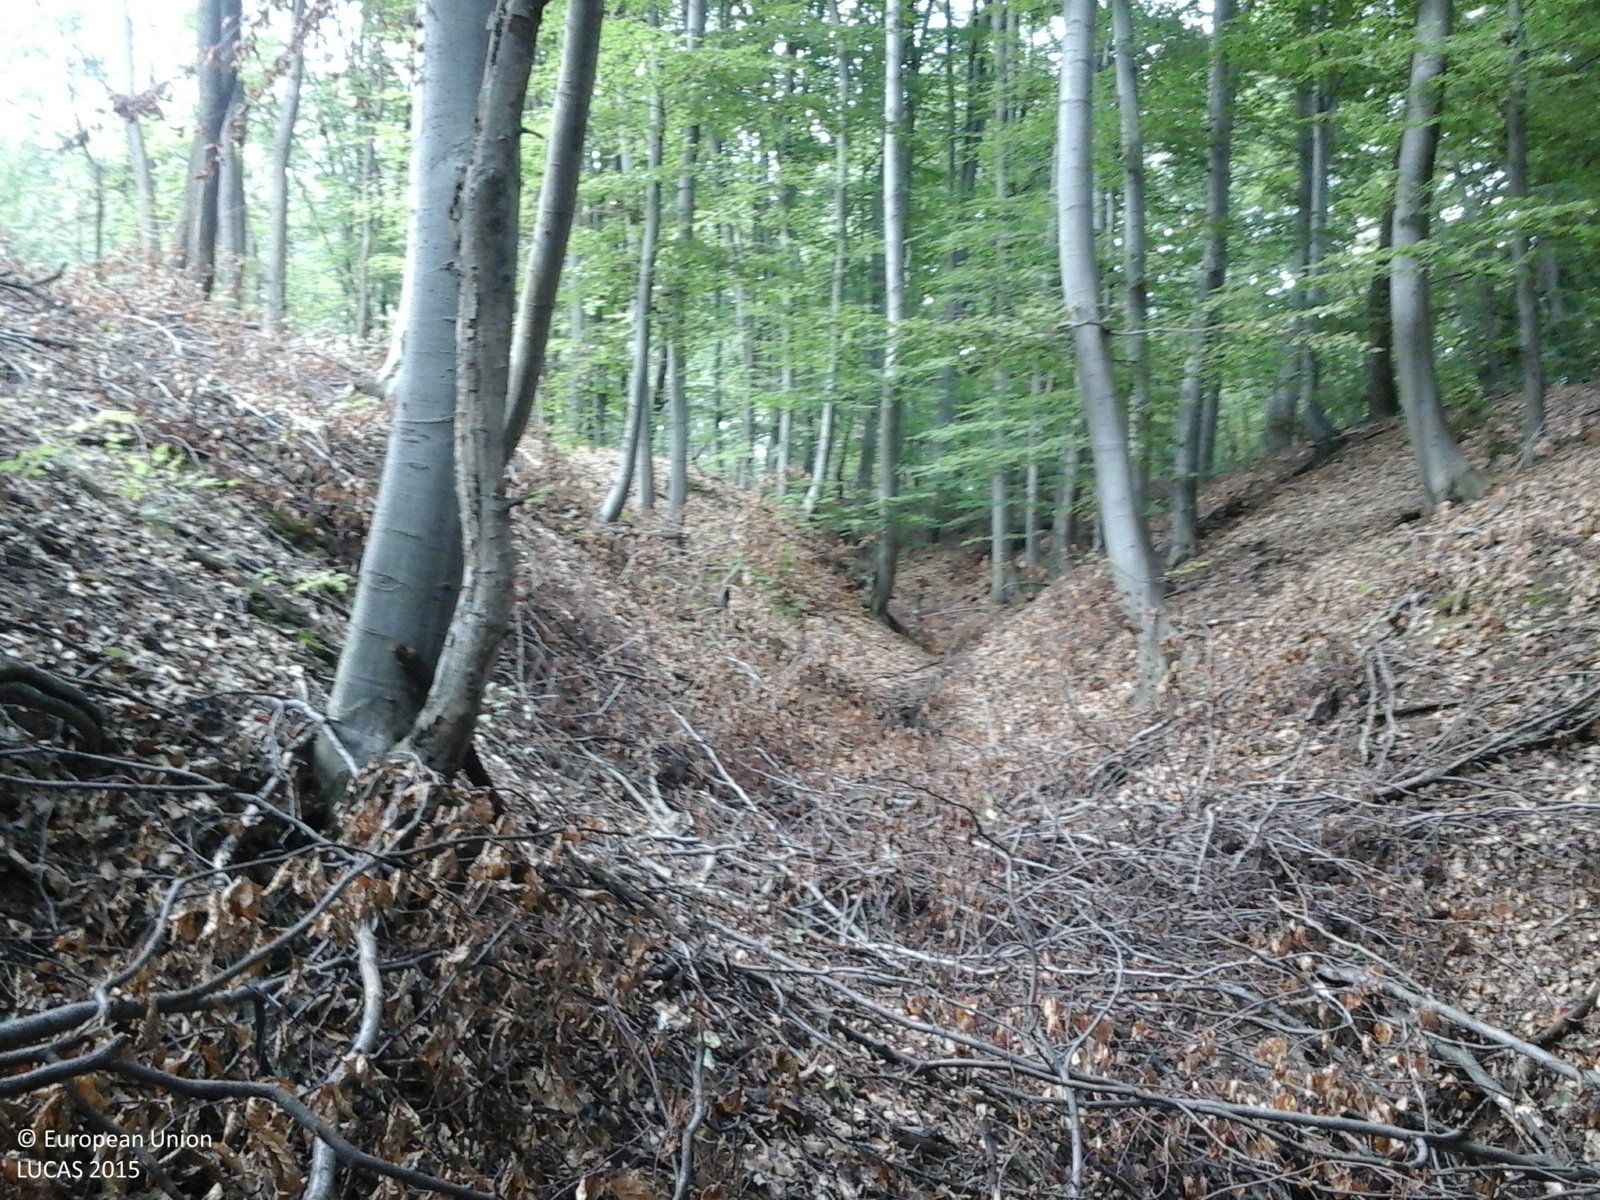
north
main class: Woodland
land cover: Broadleaved woodland
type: acidophilous oak and oak-birch forest
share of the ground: > 75 %
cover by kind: broadleaved forest trees 100 %
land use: Forestry
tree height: > 5 m
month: September
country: RO
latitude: 45.8402
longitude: 23.3351
